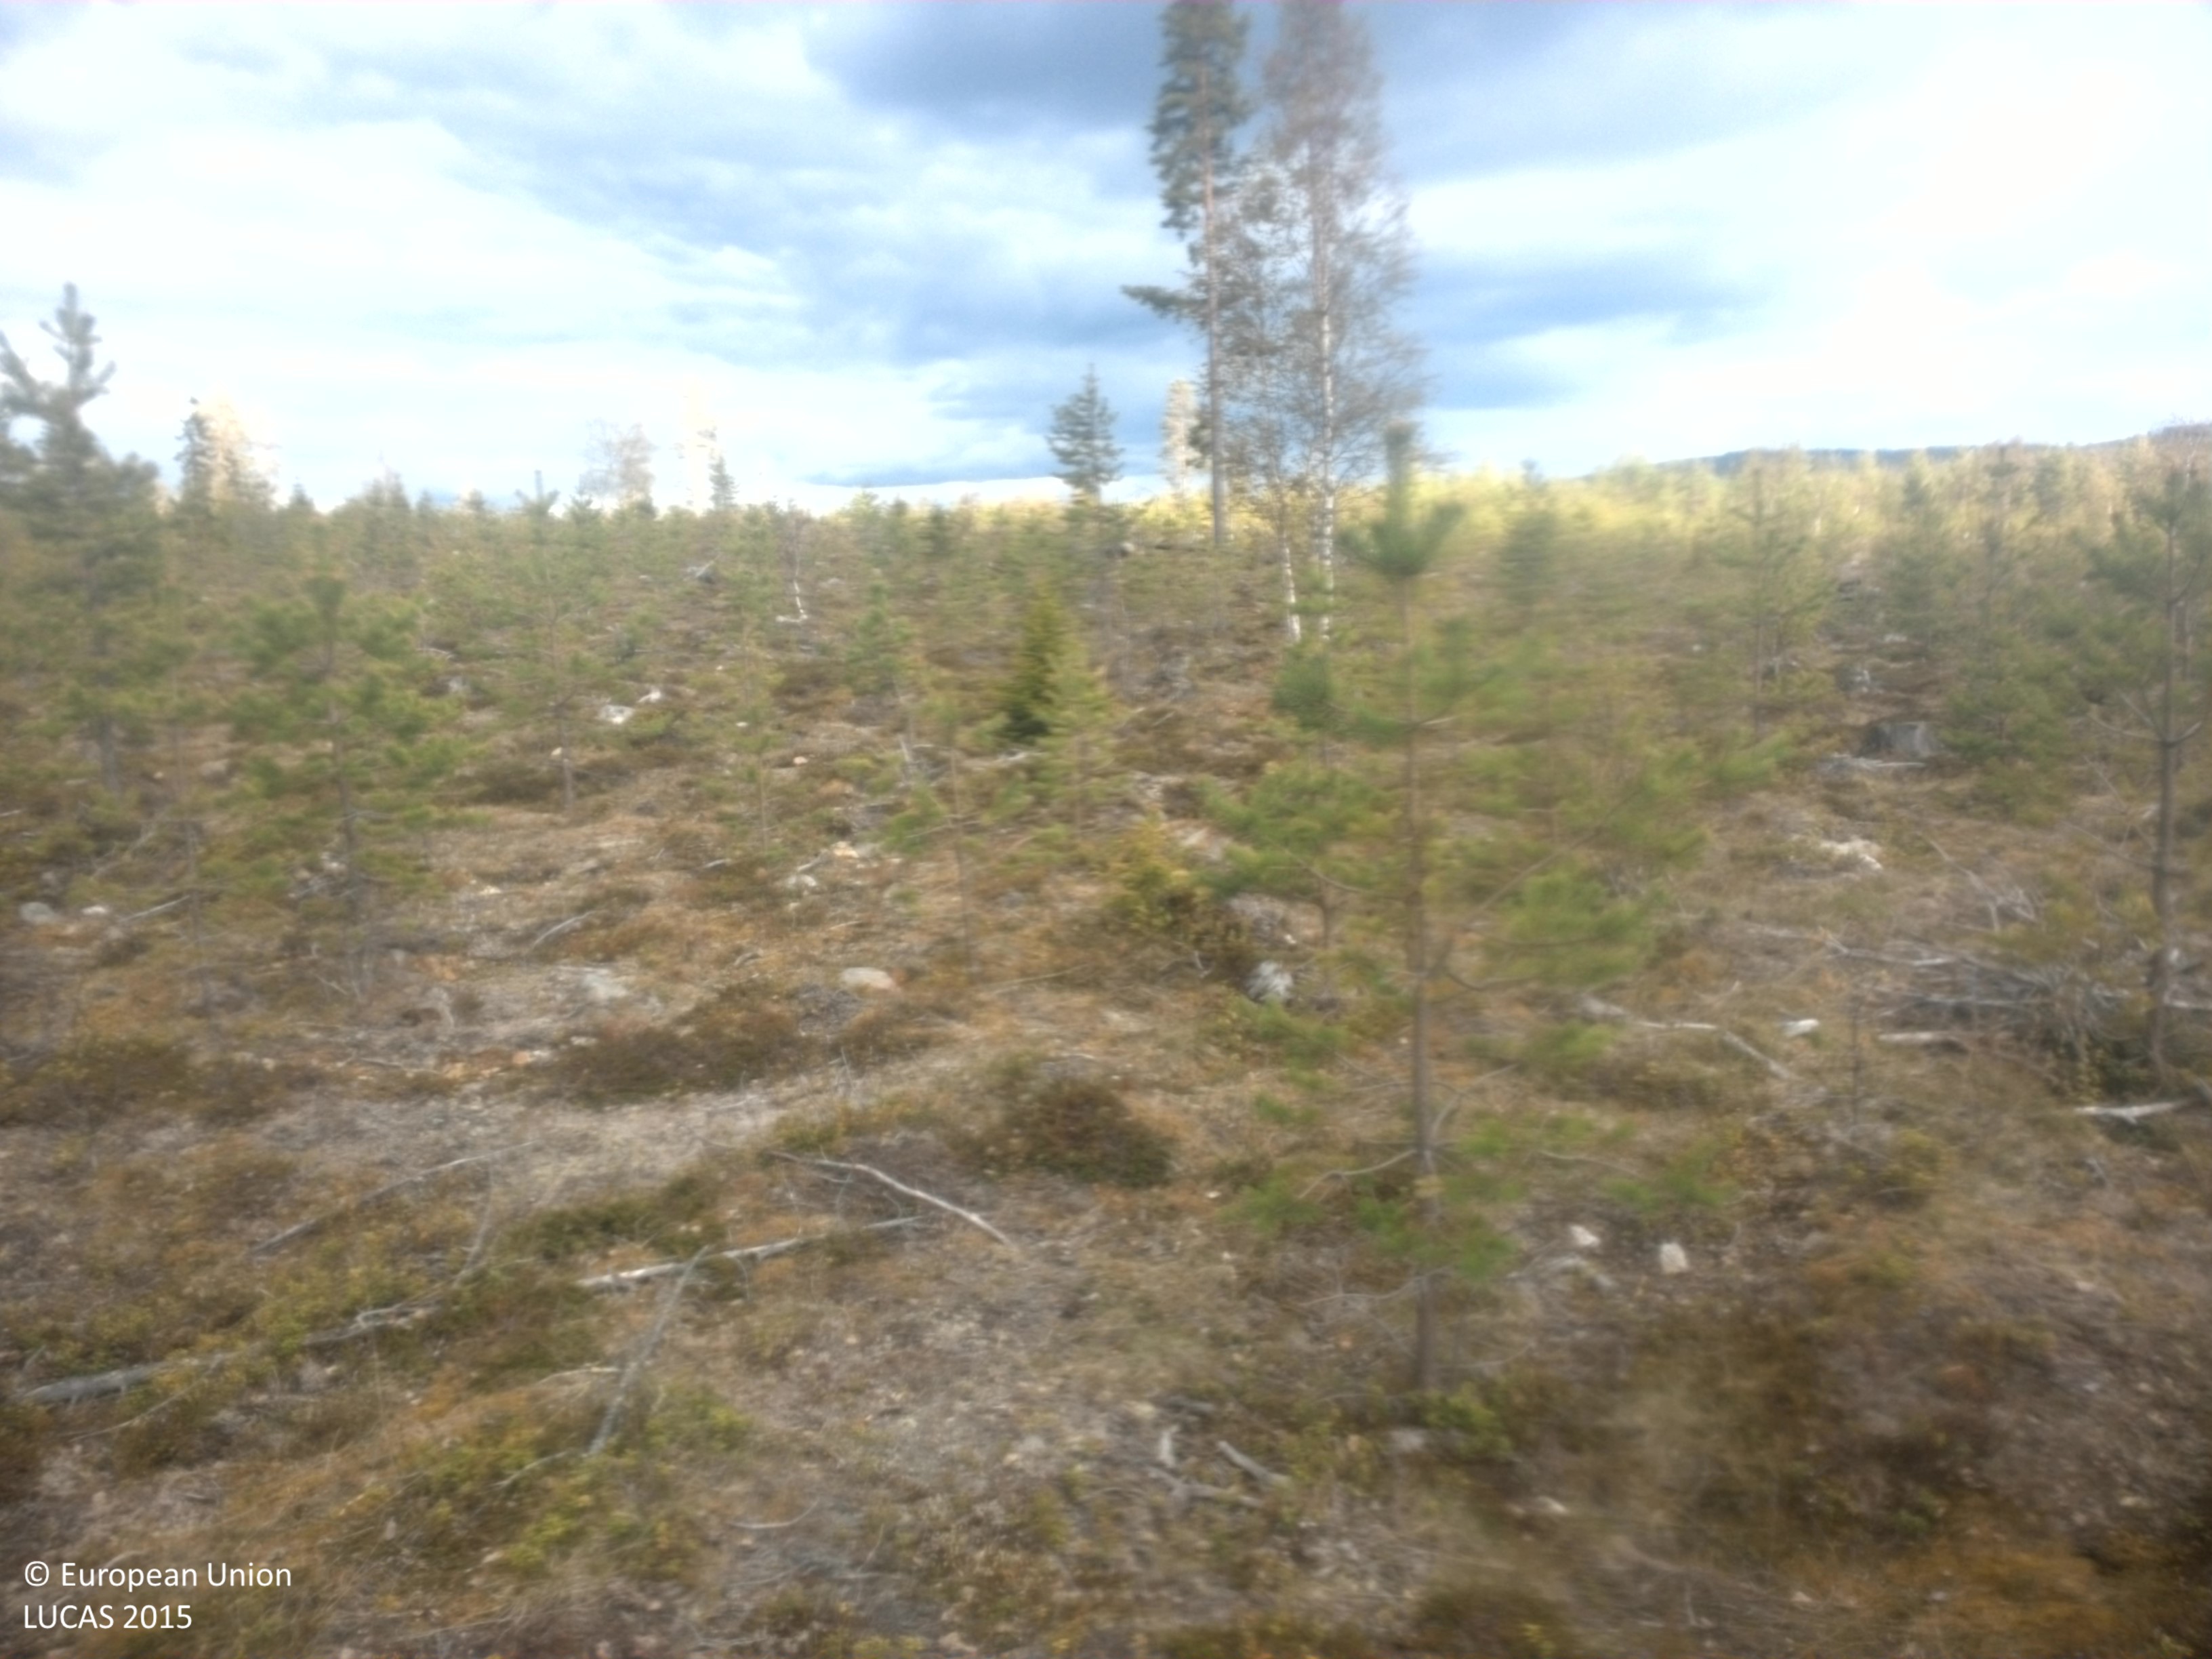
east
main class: Woodland
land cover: Pine dominated coniferous woodland
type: boreal forest
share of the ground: 10 - 25 %
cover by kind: herbaceous plants 35 %, lichens and mosses 25 %, coniferous forest trees 20 %, unconsolidated bare surface 10 %, broadleaved forest trees 5 %, shrubs 5 %
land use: Forestry
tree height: < 5 m
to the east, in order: Pine dominated coniferous woodland
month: June
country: SE
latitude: 64.3746
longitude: 17.6981
